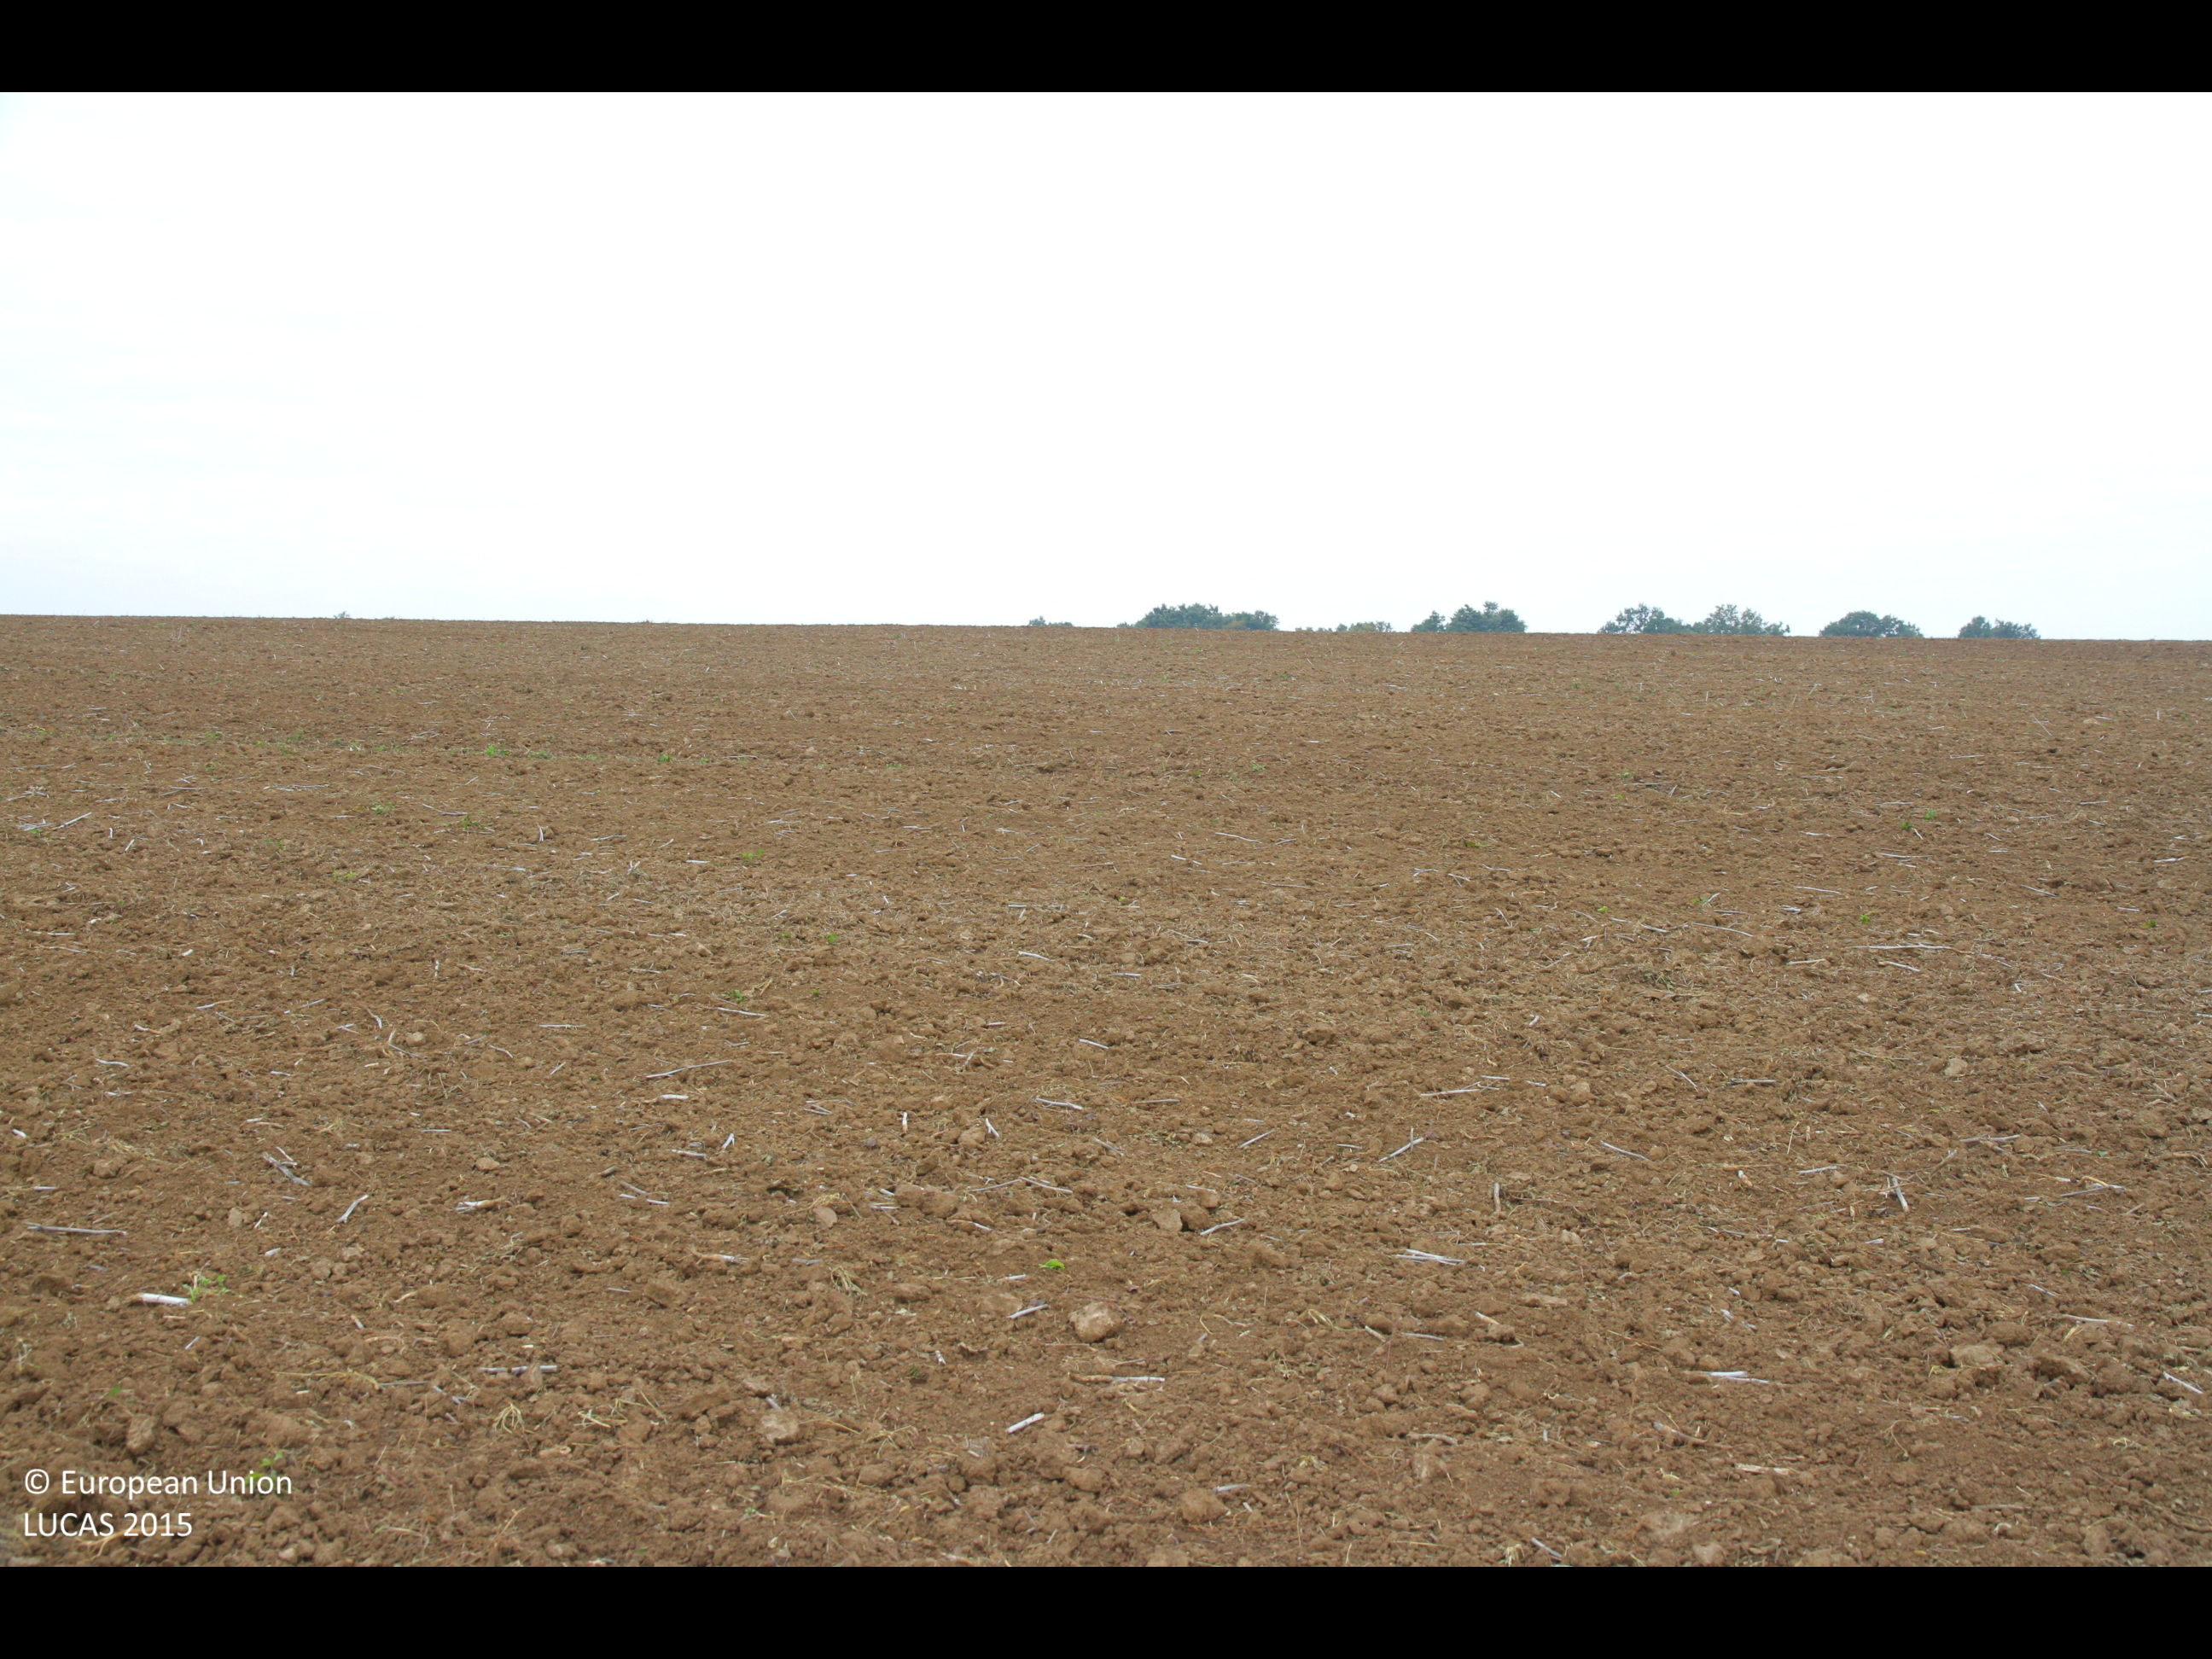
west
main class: Cropland
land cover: Rape and turnip rape
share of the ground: < 10 %
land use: Agriculture (excluding fallow land and kitchen gardens)
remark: Harvested field
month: October
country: BG
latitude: 43.5015
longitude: 27.0249
